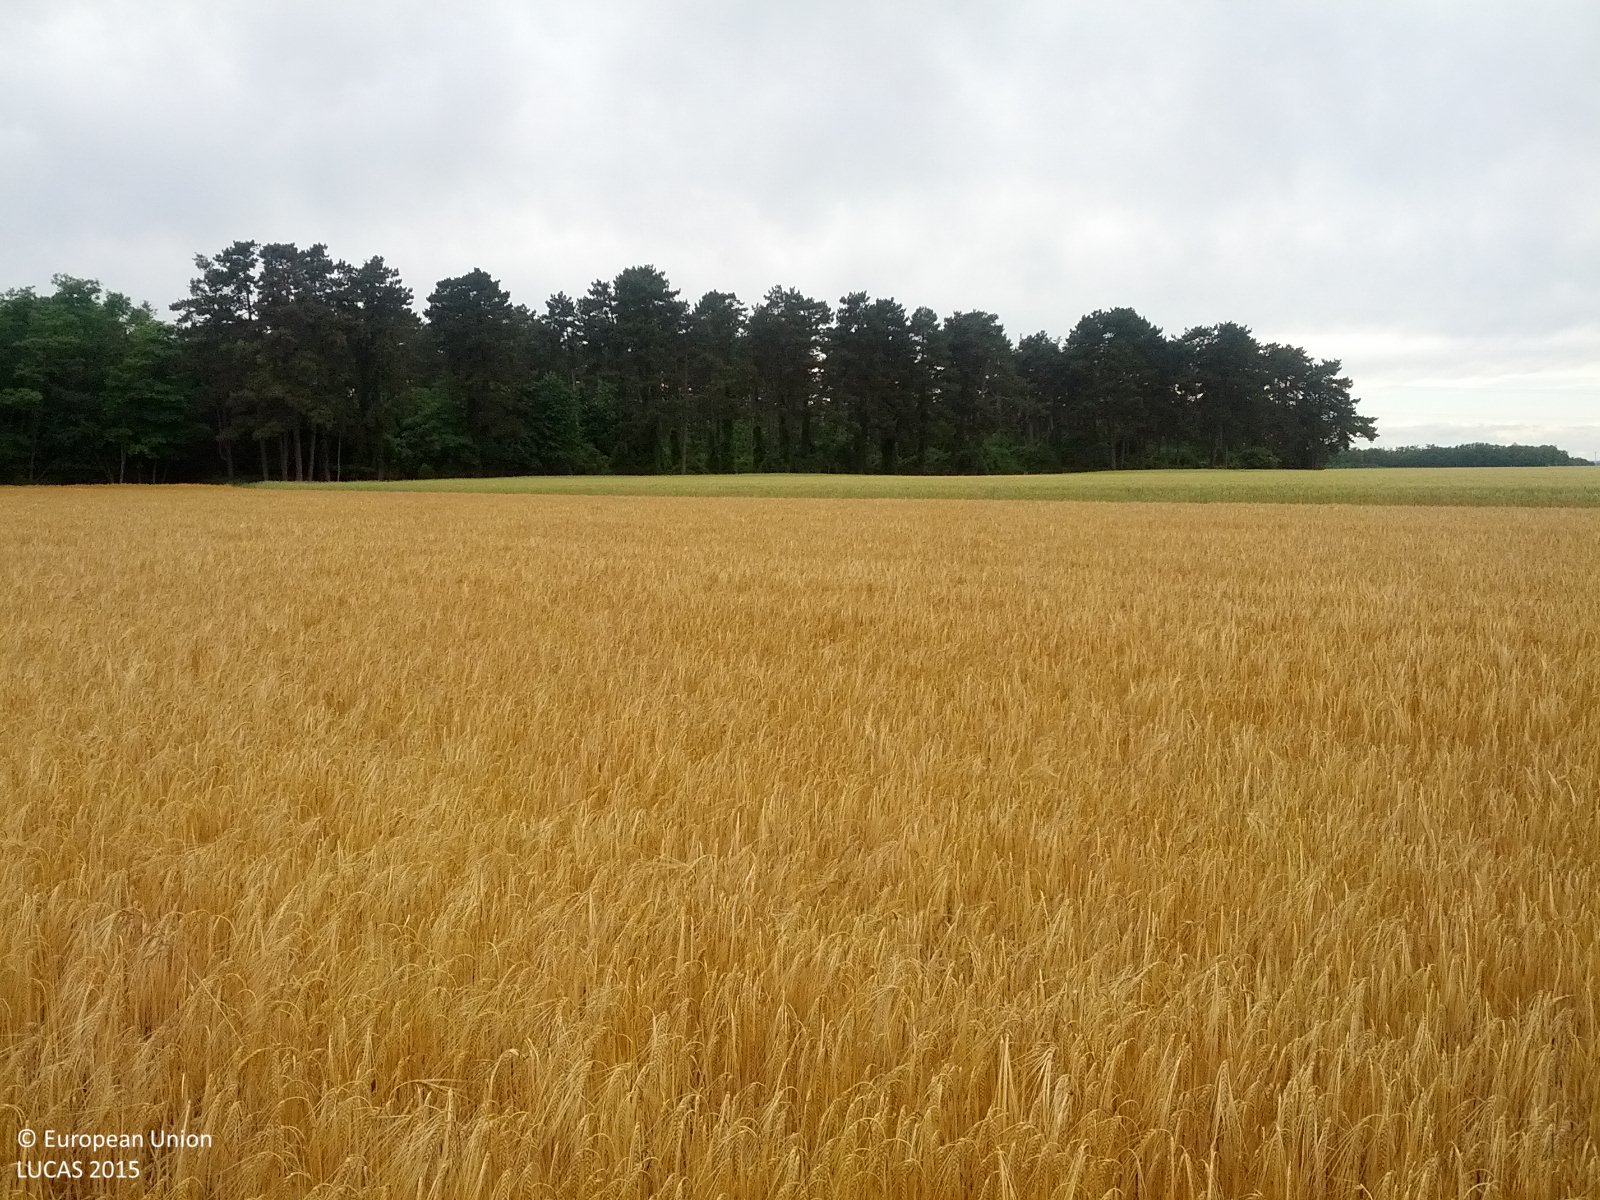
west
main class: Cropland
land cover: Barley
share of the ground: > 75 %
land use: Agriculture (excluding fallow land and kitchen gardens)
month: June
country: AT
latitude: 48.3032
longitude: 16.7881
